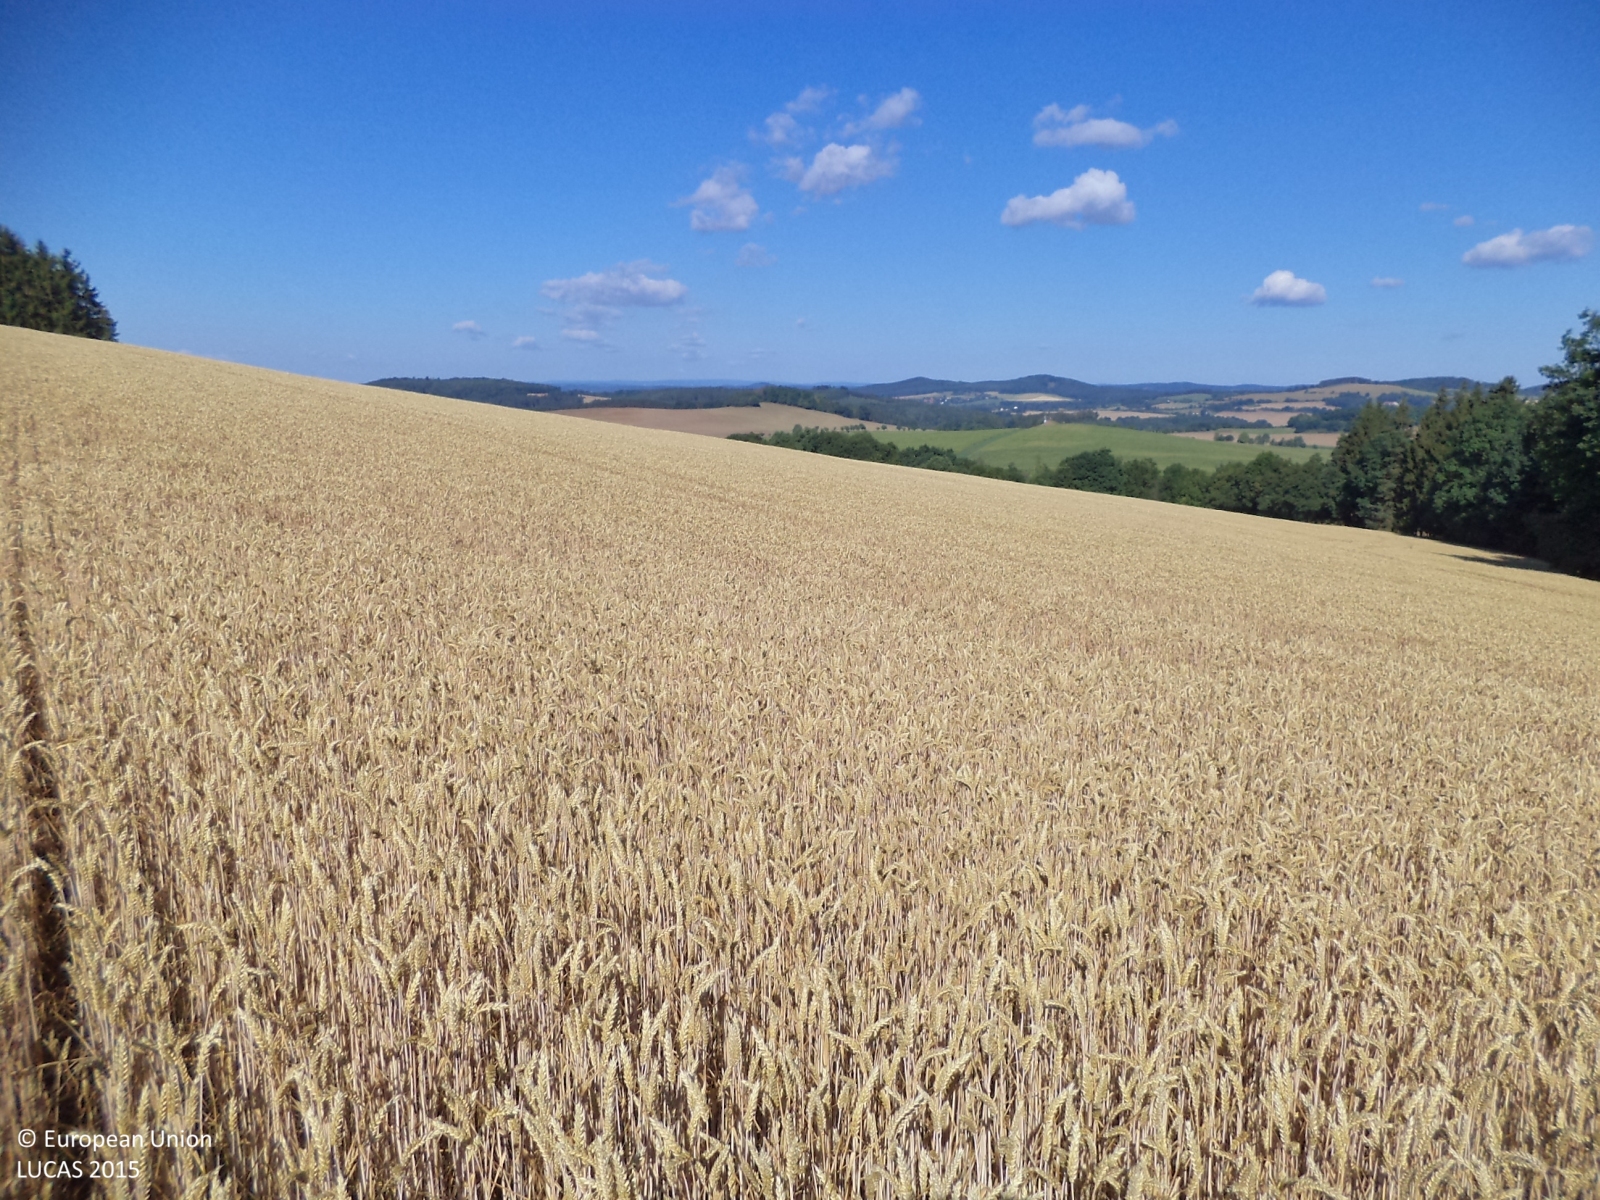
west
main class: Cropland
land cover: Common wheat
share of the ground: > 75 %
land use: Agriculture (excluding fallow land and kitchen gardens)
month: July
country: CZ
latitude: 49.7011
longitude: 14.4522
